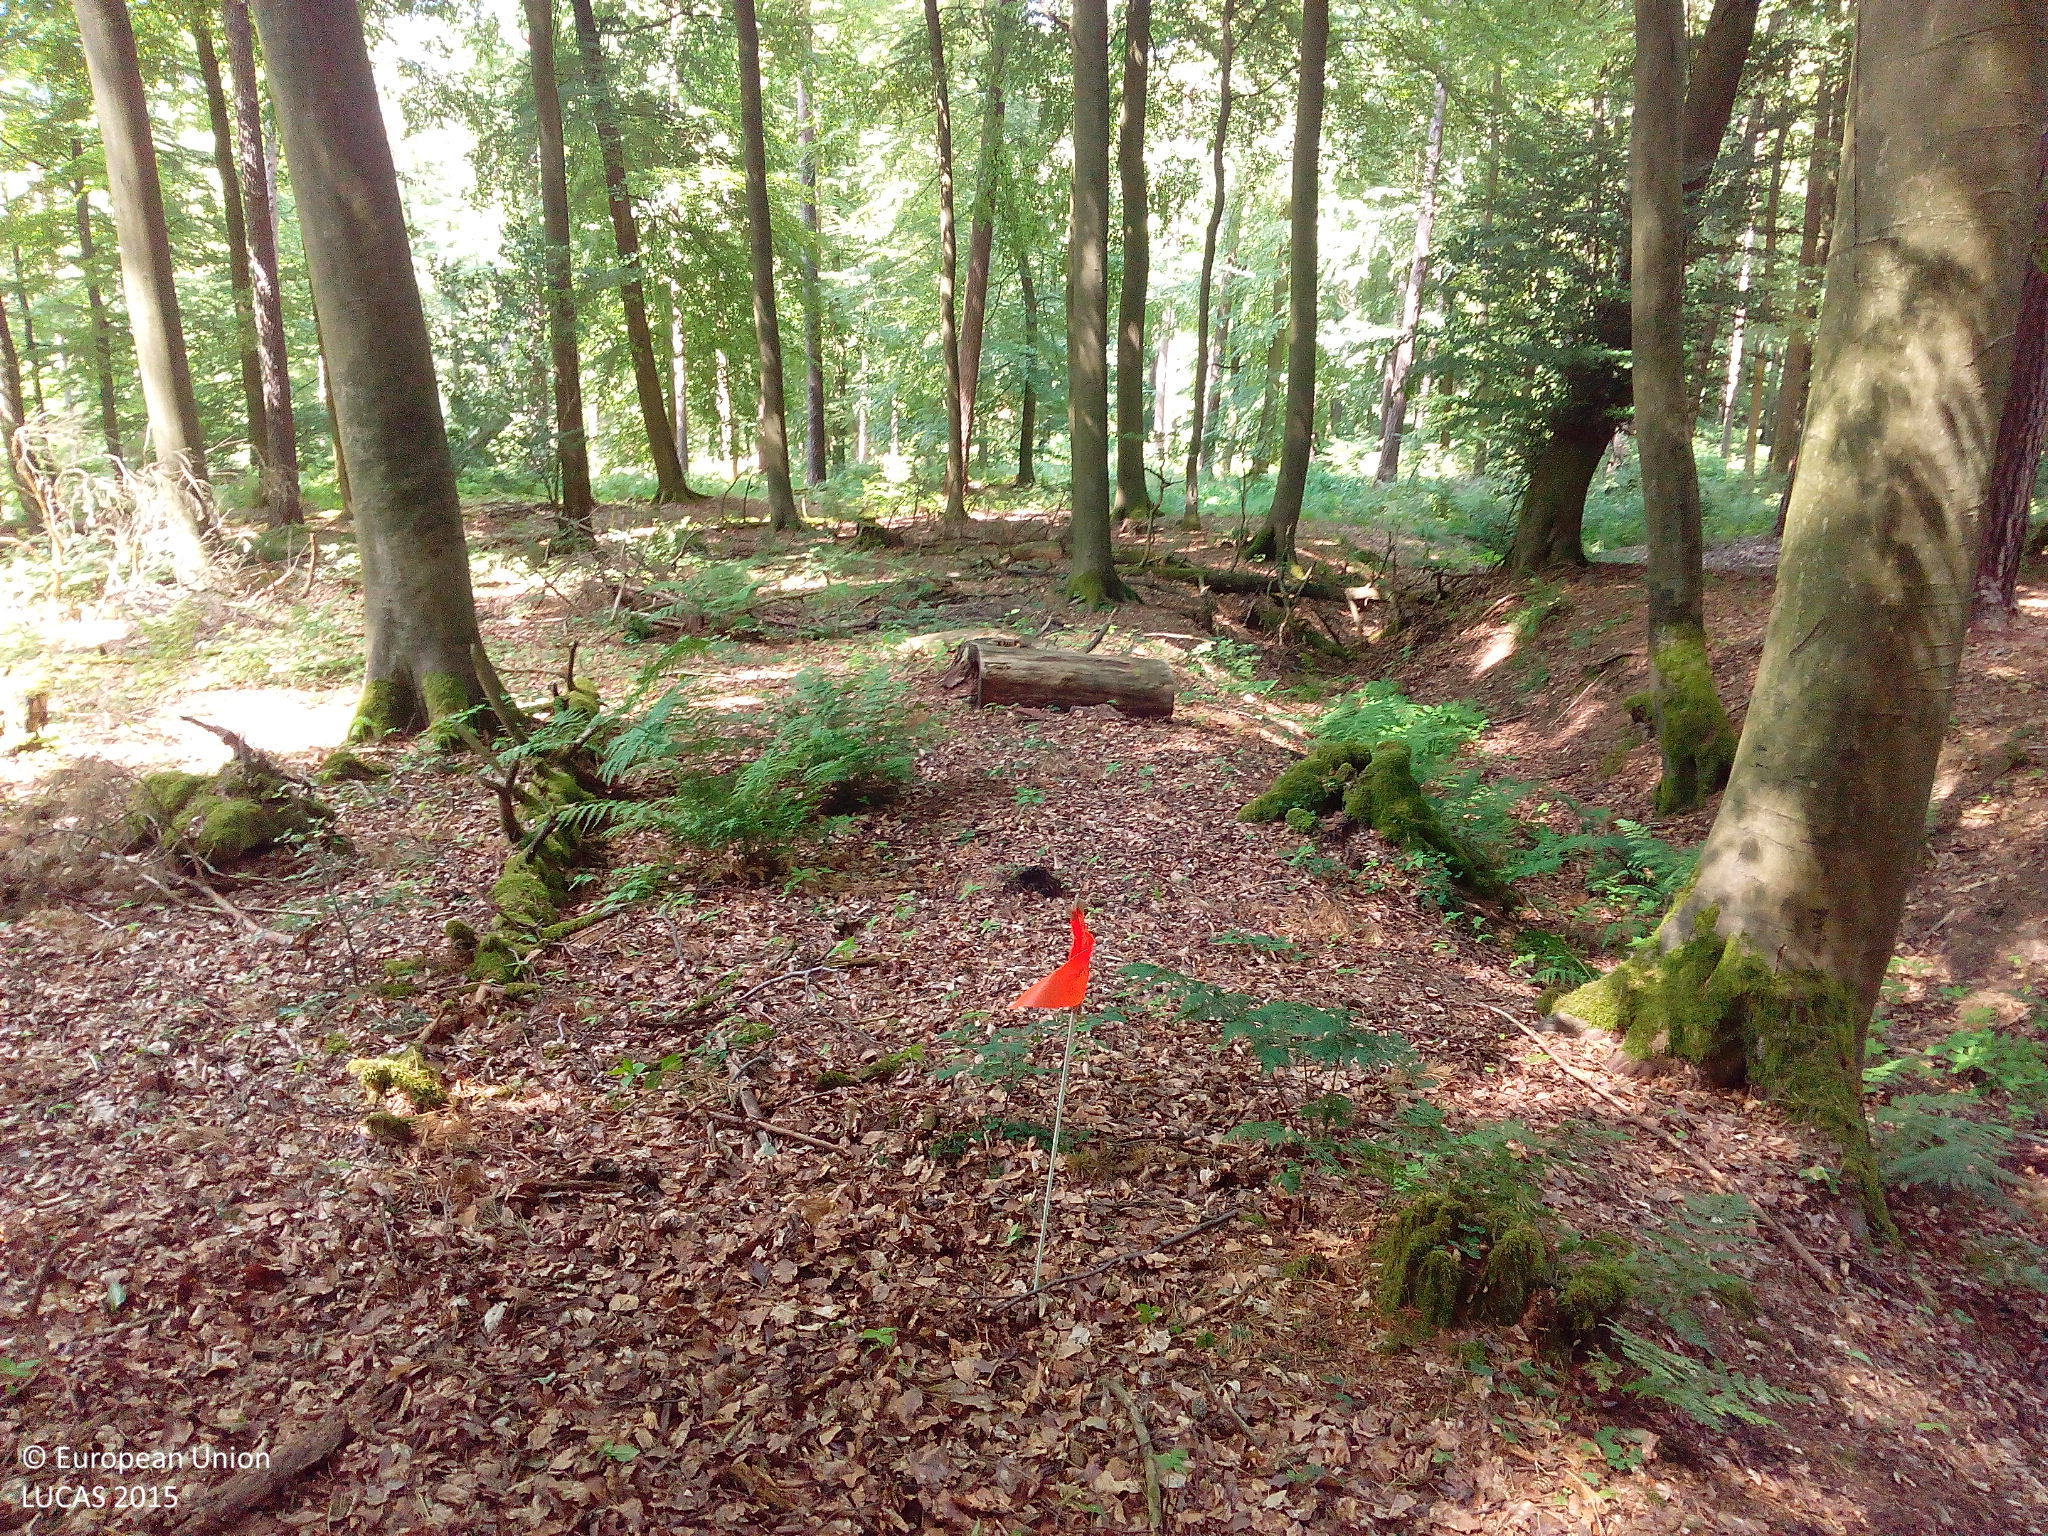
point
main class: Woodland
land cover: Pine dominated mixed woodland
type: hemiboreal forest and nemoral coniferous forest and mixed broadleaved-coniferous forest
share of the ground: > 75 %
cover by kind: broadleaved forest trees 60 %, coniferous forest trees 25 %, unconsolidated bare surface 10 %, shrubs 5 %
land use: Forestry
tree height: > 5 m
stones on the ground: < 10 %
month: July
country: DE
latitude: 50.9753
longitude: 9.9003
